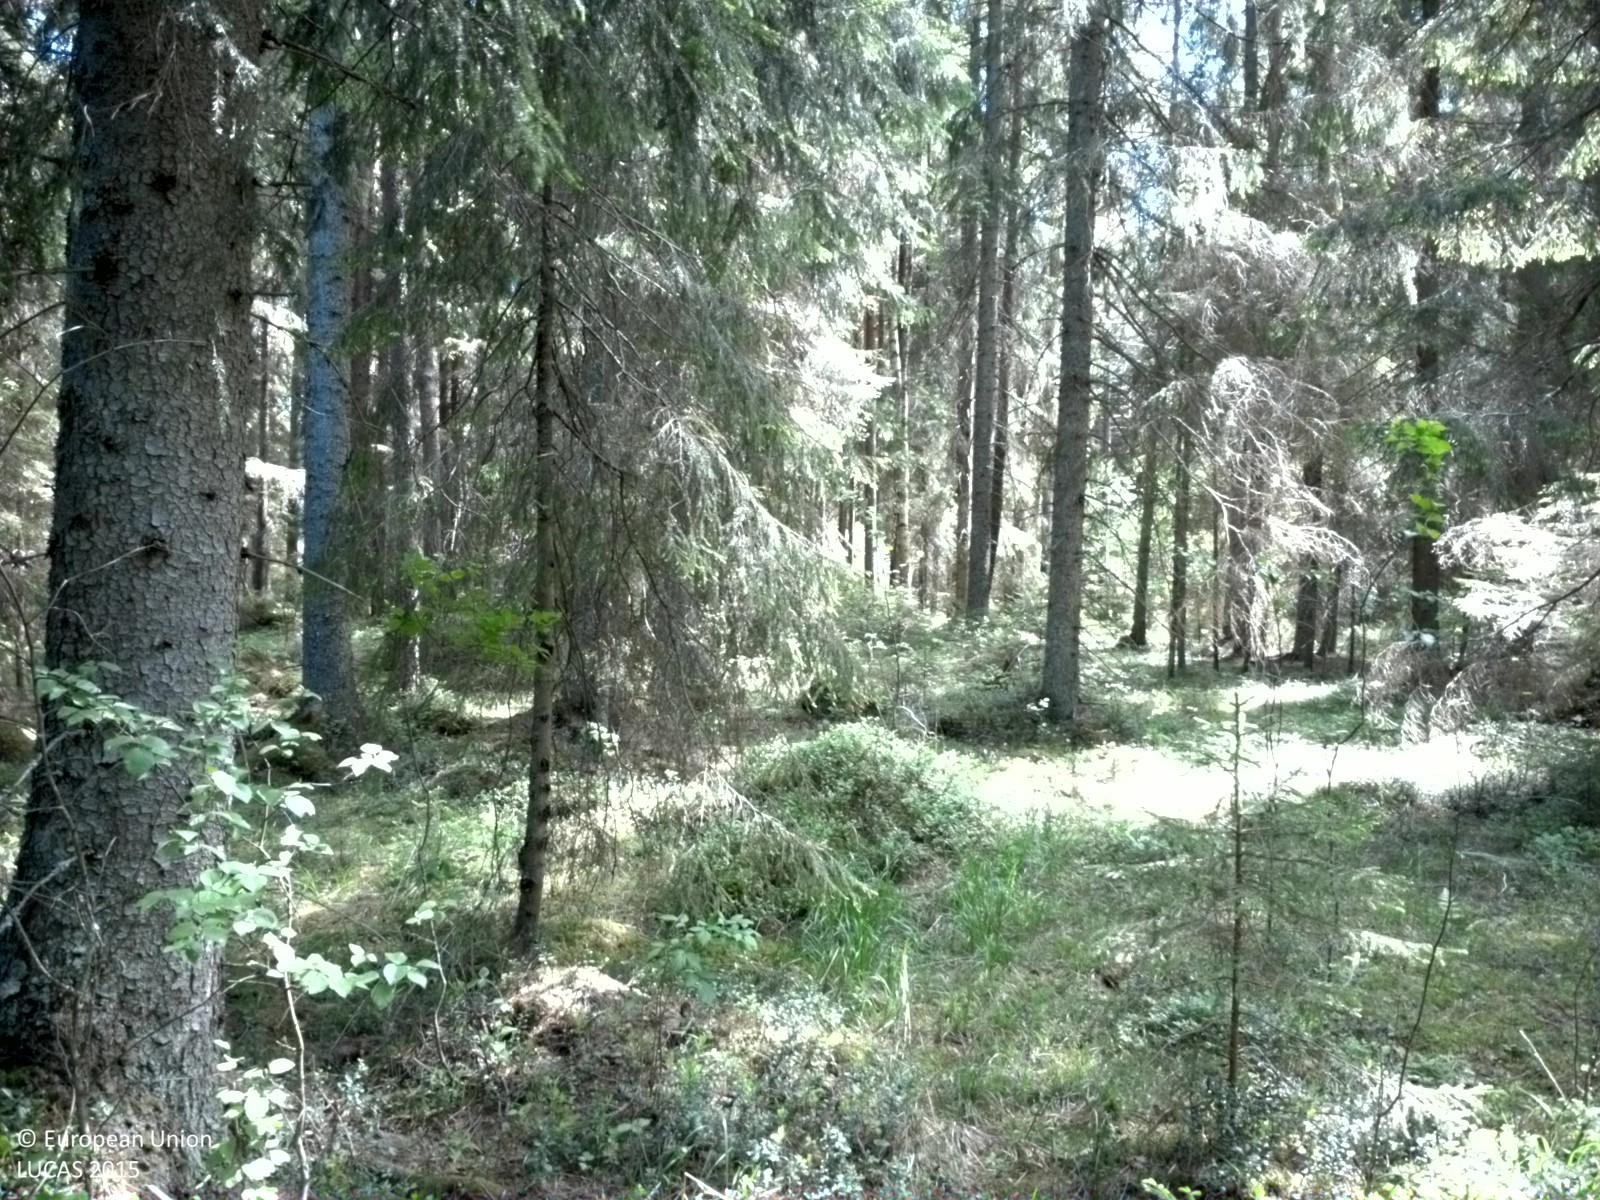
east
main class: Woodland
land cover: Spruce dominated coniferous woodland
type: boreal forest
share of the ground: > 75 %
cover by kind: coniferous forest trees 70 %, shrubs 10 %, lichens and mosses 10 %, broadleaved forest trees 5 %, herbaceous plants 5 %
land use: Forestry
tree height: > 5 m
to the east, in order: Spruce dominated coniferous woodland; Pine dominated coniferous woodland; Other coniferous woodland; Spruce dominated mixed woodland; Broadleaved woodland; Spruce dominated mixed woodland; Spruce dominated coniferous woodland; Tracks; Spruce dominated coniferous woodland; Tracks; Spruce dominated coniferous woodland
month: June
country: SE
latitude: 60.3197
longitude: 17.2511
